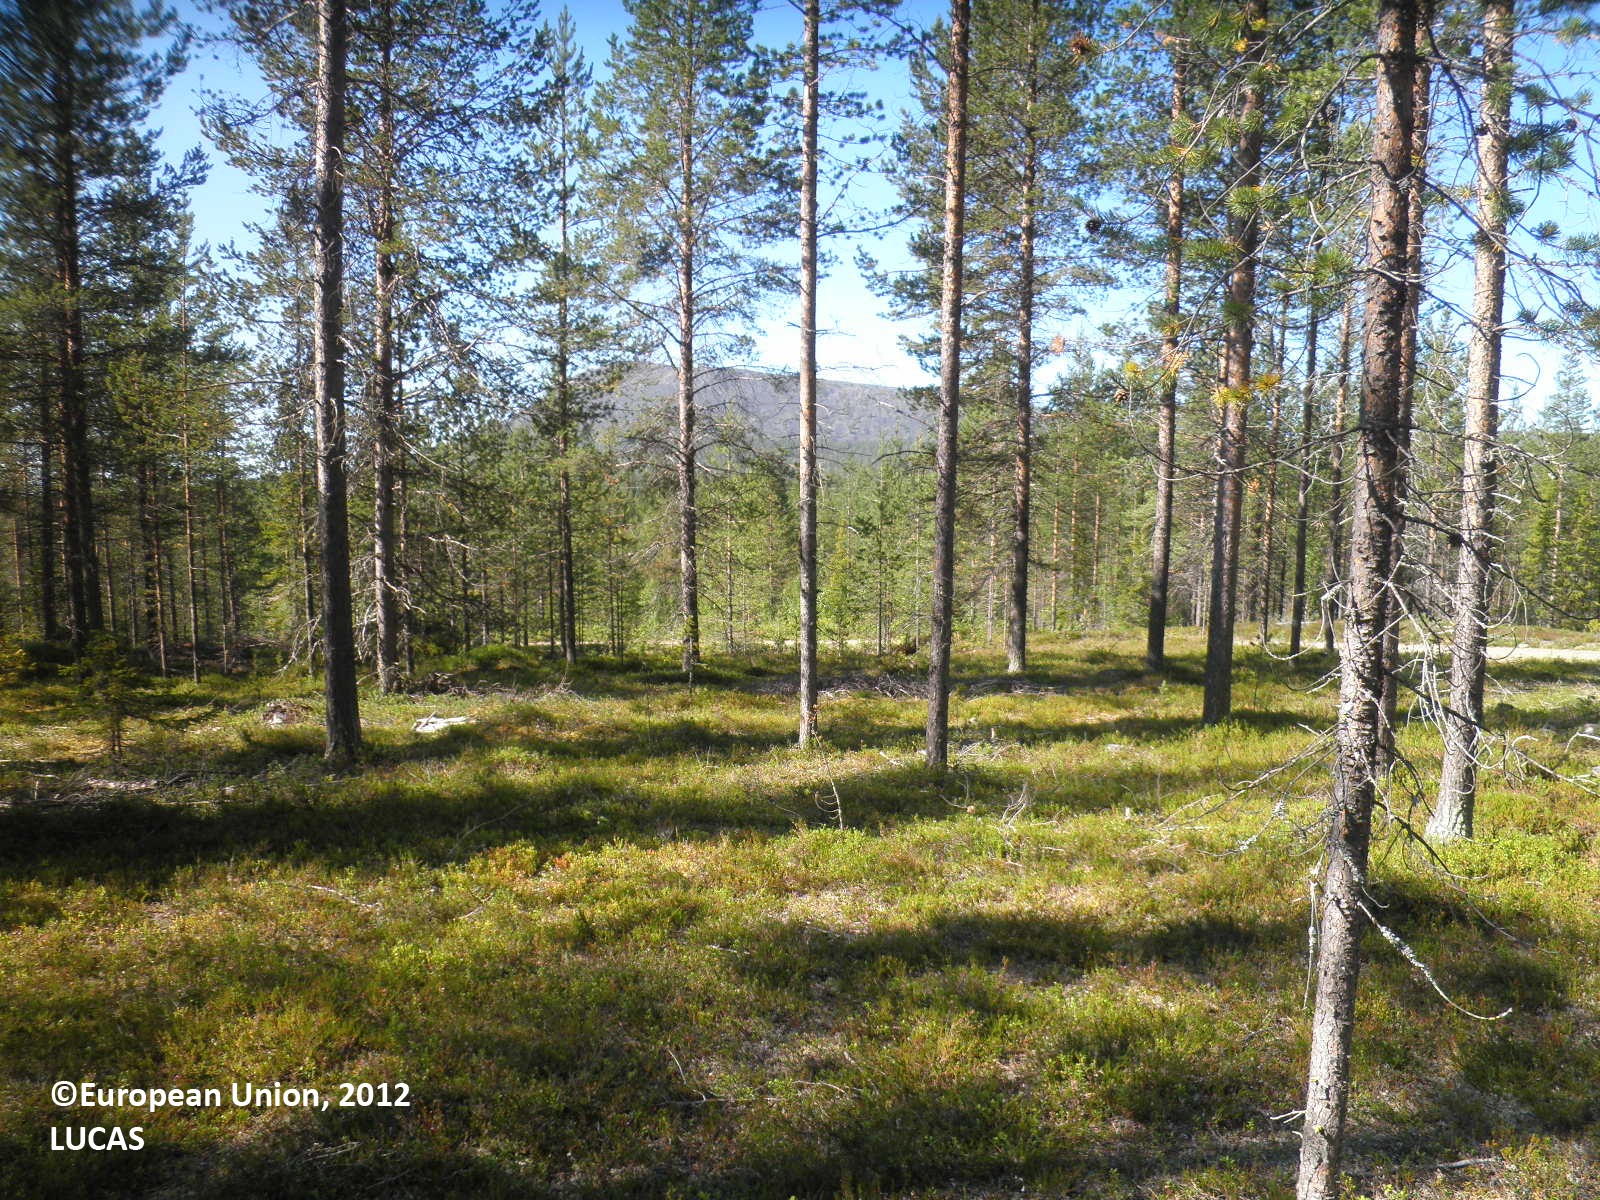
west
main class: Woodland
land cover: Pine dominated coniferous woodland
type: boreal forest
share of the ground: 25 - 50 %
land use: Forestry
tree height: > 5 m
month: August
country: FI
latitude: 67.7313
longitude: 25.6315
